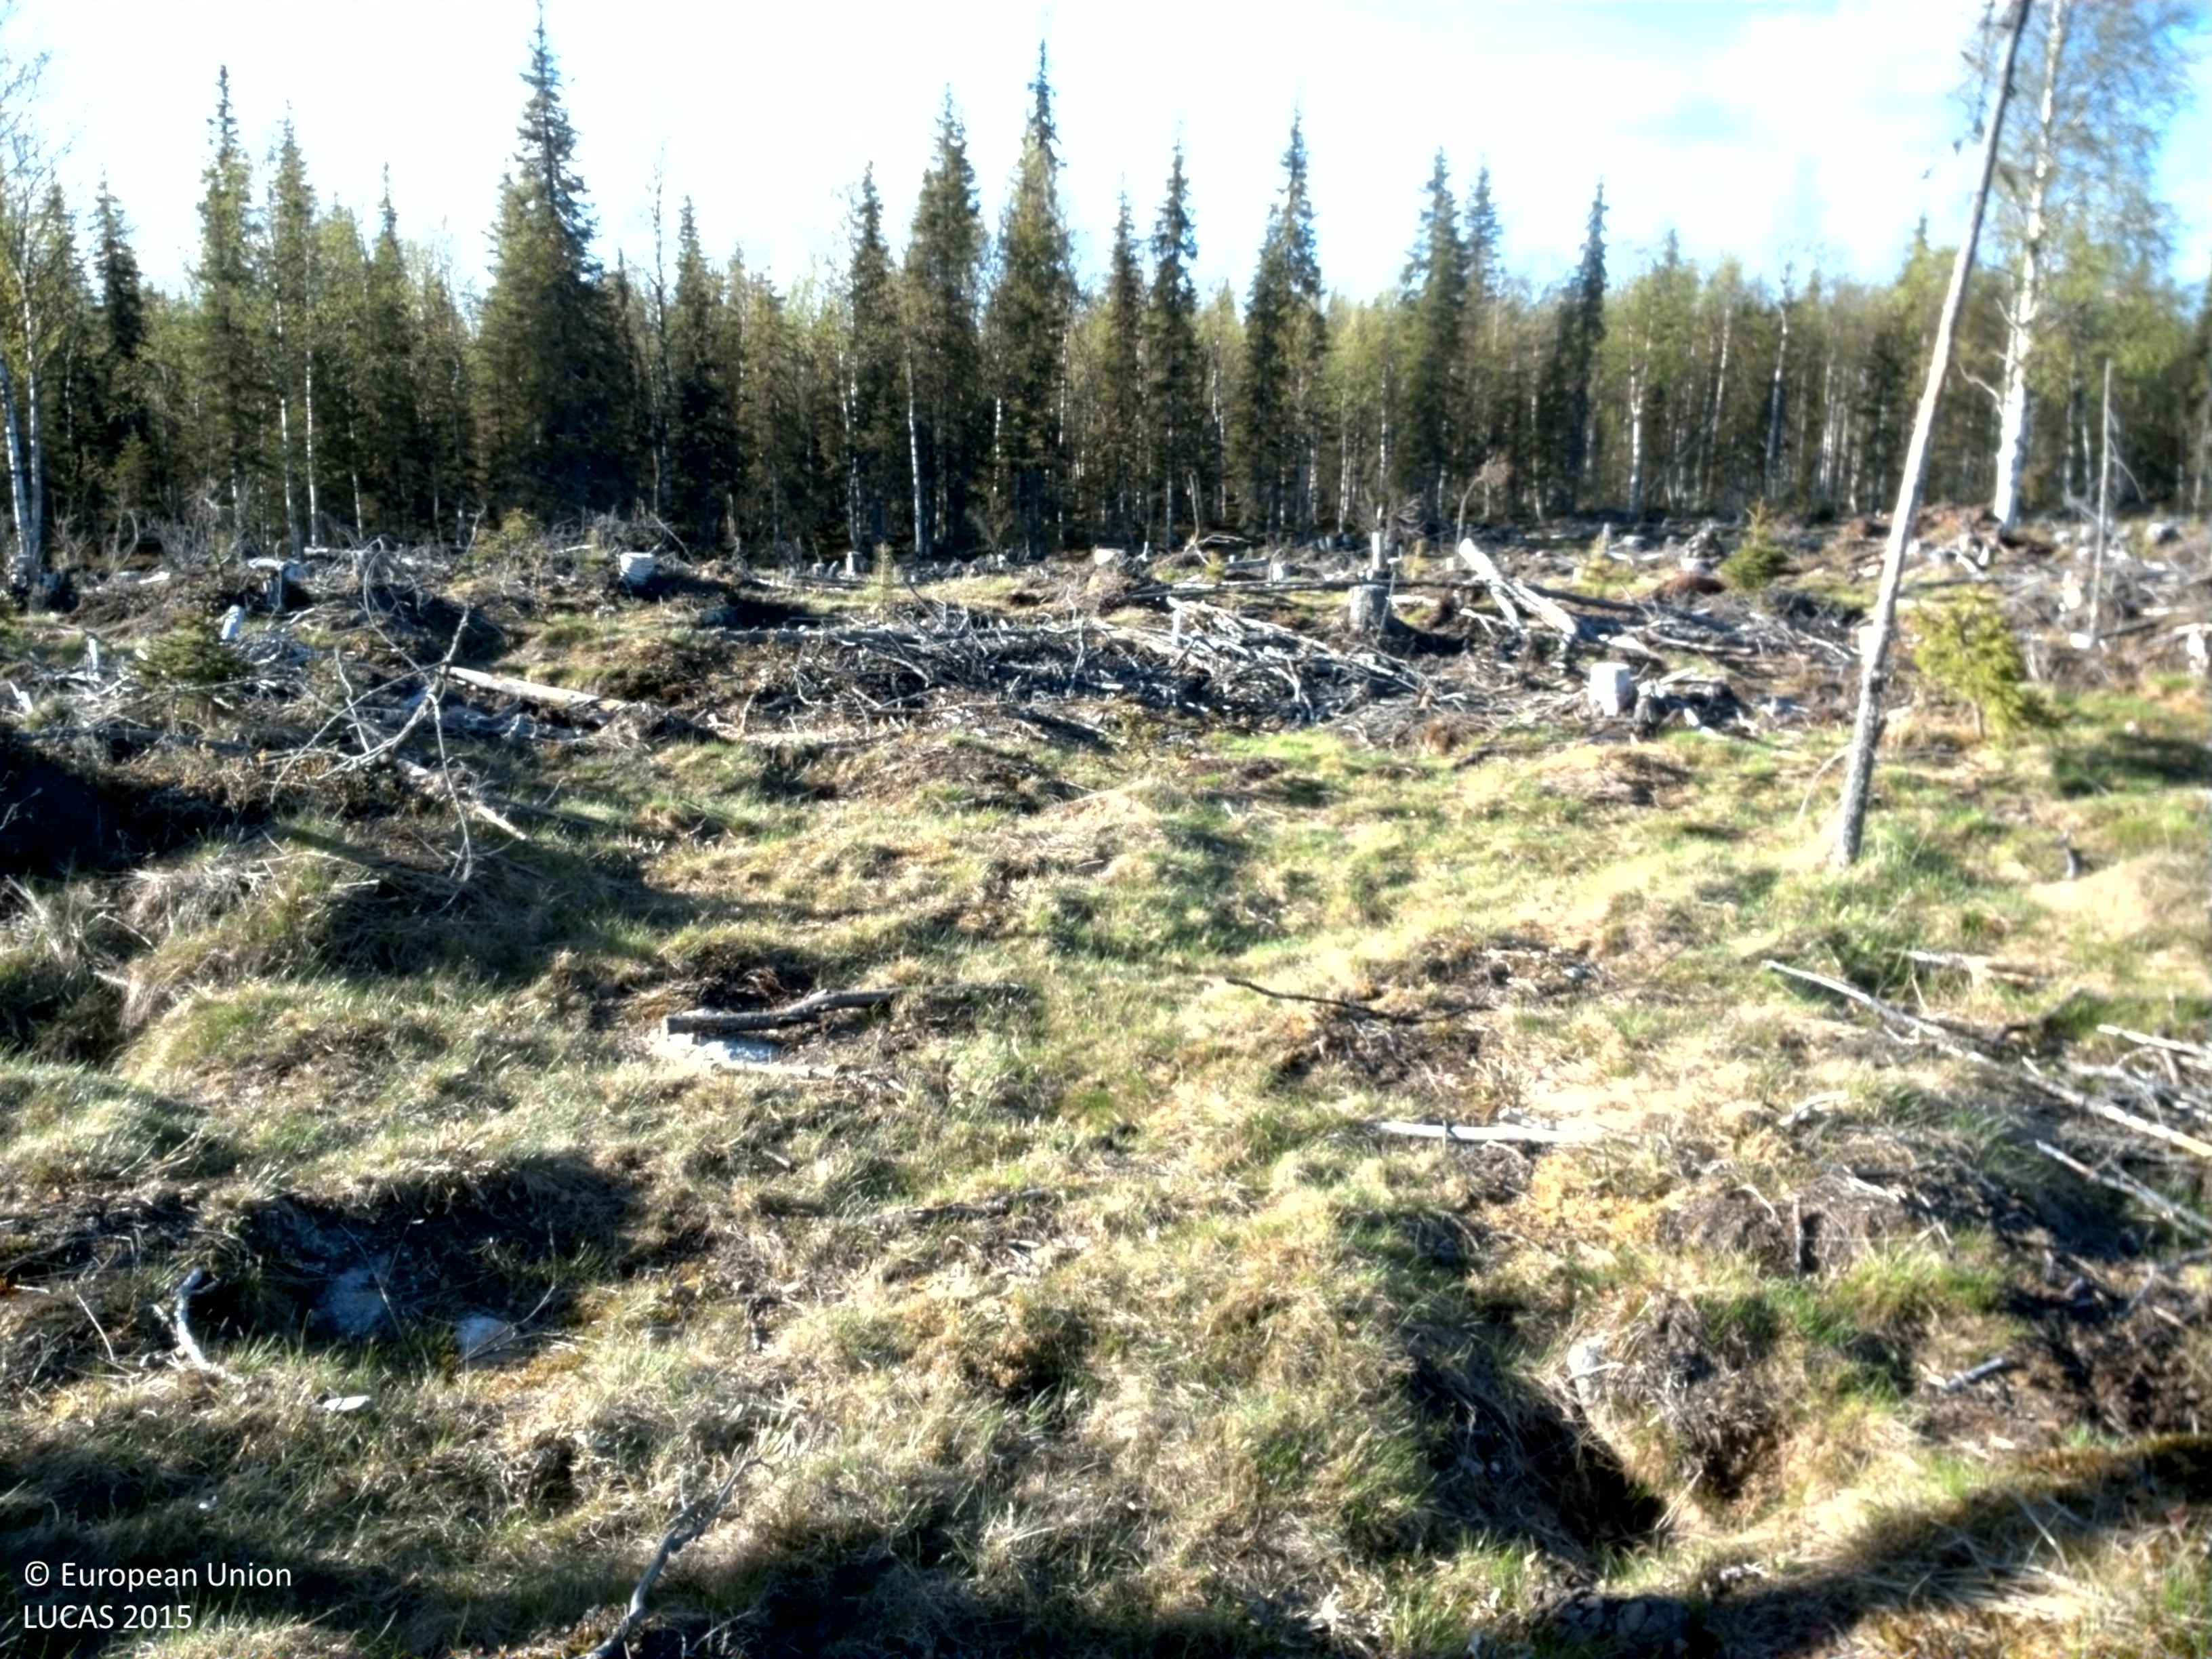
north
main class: Grassland
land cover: Grassland with sparse tree/shrub cover
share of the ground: > 75 %
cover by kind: herbaceous plants 80 %, coniferous forest trees 5 %, shrubs 5 %, lichens and mosses 5 %, unconsolidated bare surface 5 %
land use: Forestry
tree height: > 5 m
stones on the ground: < 10 %
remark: Clear cut
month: June
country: SE
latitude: 66.8708
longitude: 21.2488
